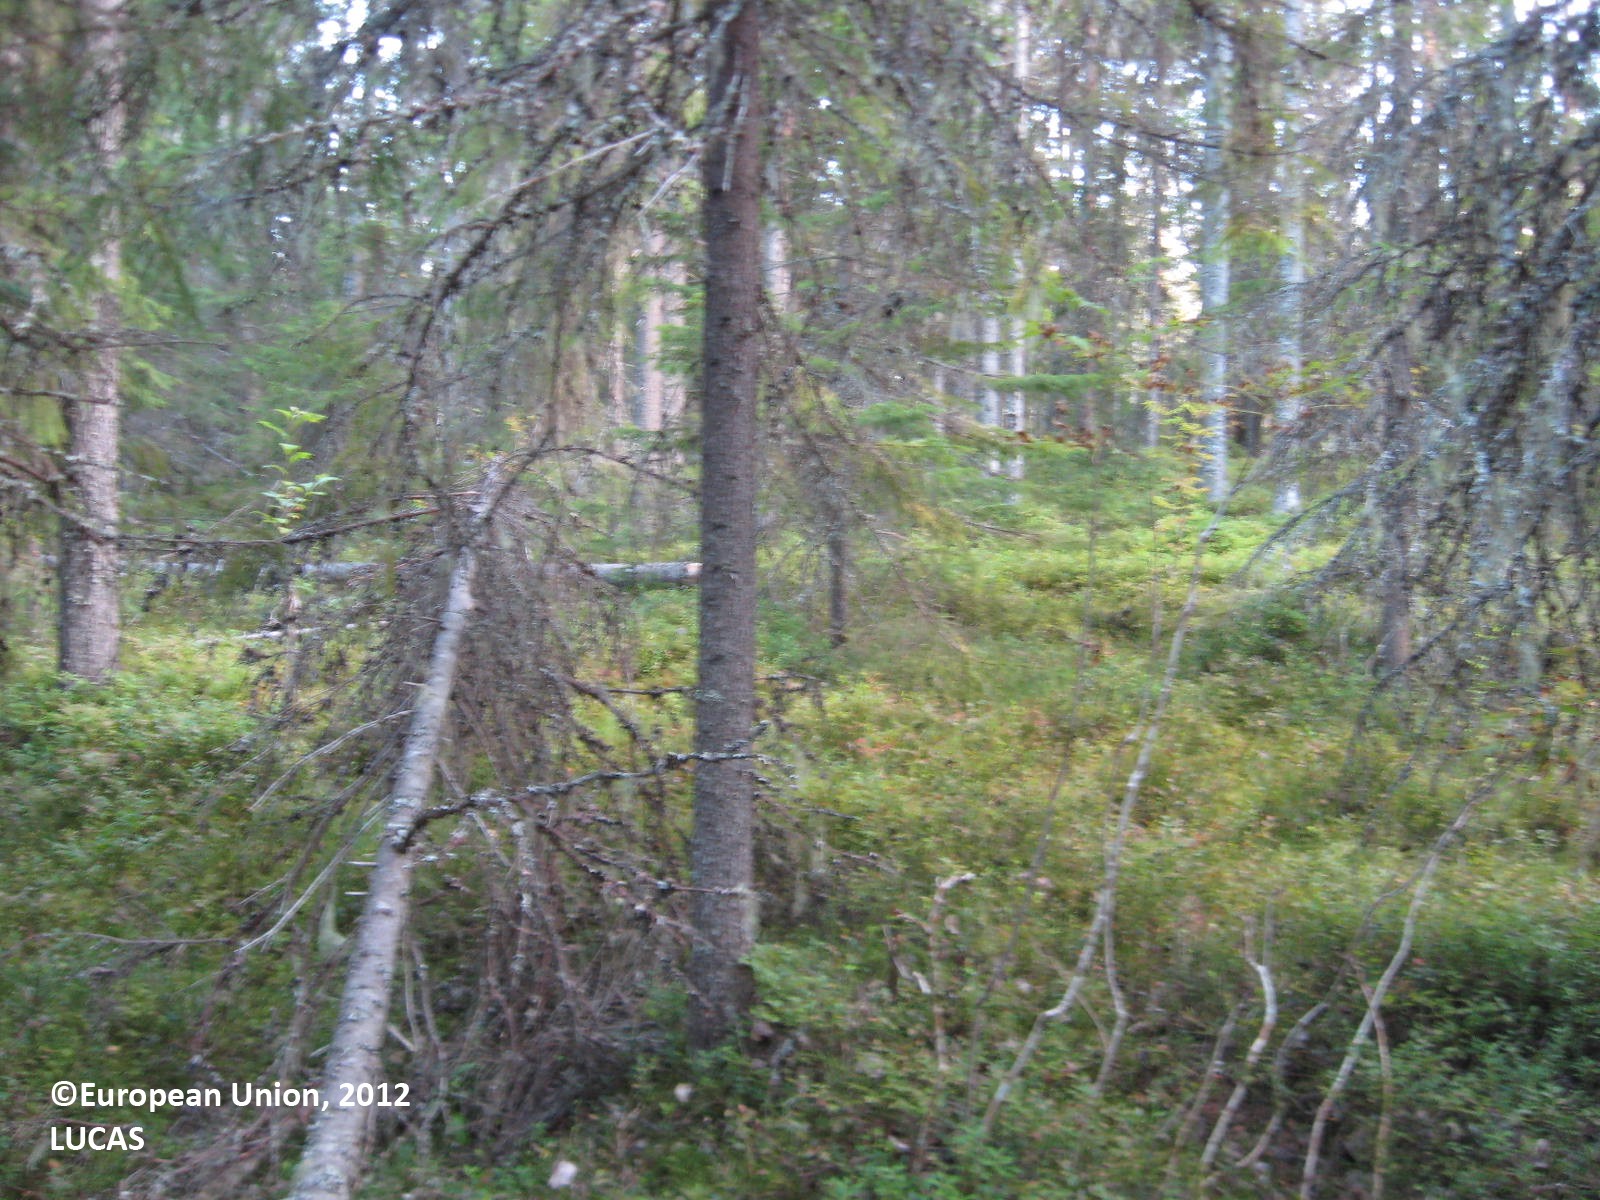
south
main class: Woodland
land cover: Other coniferous woodland
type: boreal forest
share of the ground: > 75 %
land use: Forestry
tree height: > 5 m
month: August
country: FI
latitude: 63.8789
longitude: 29.7982
